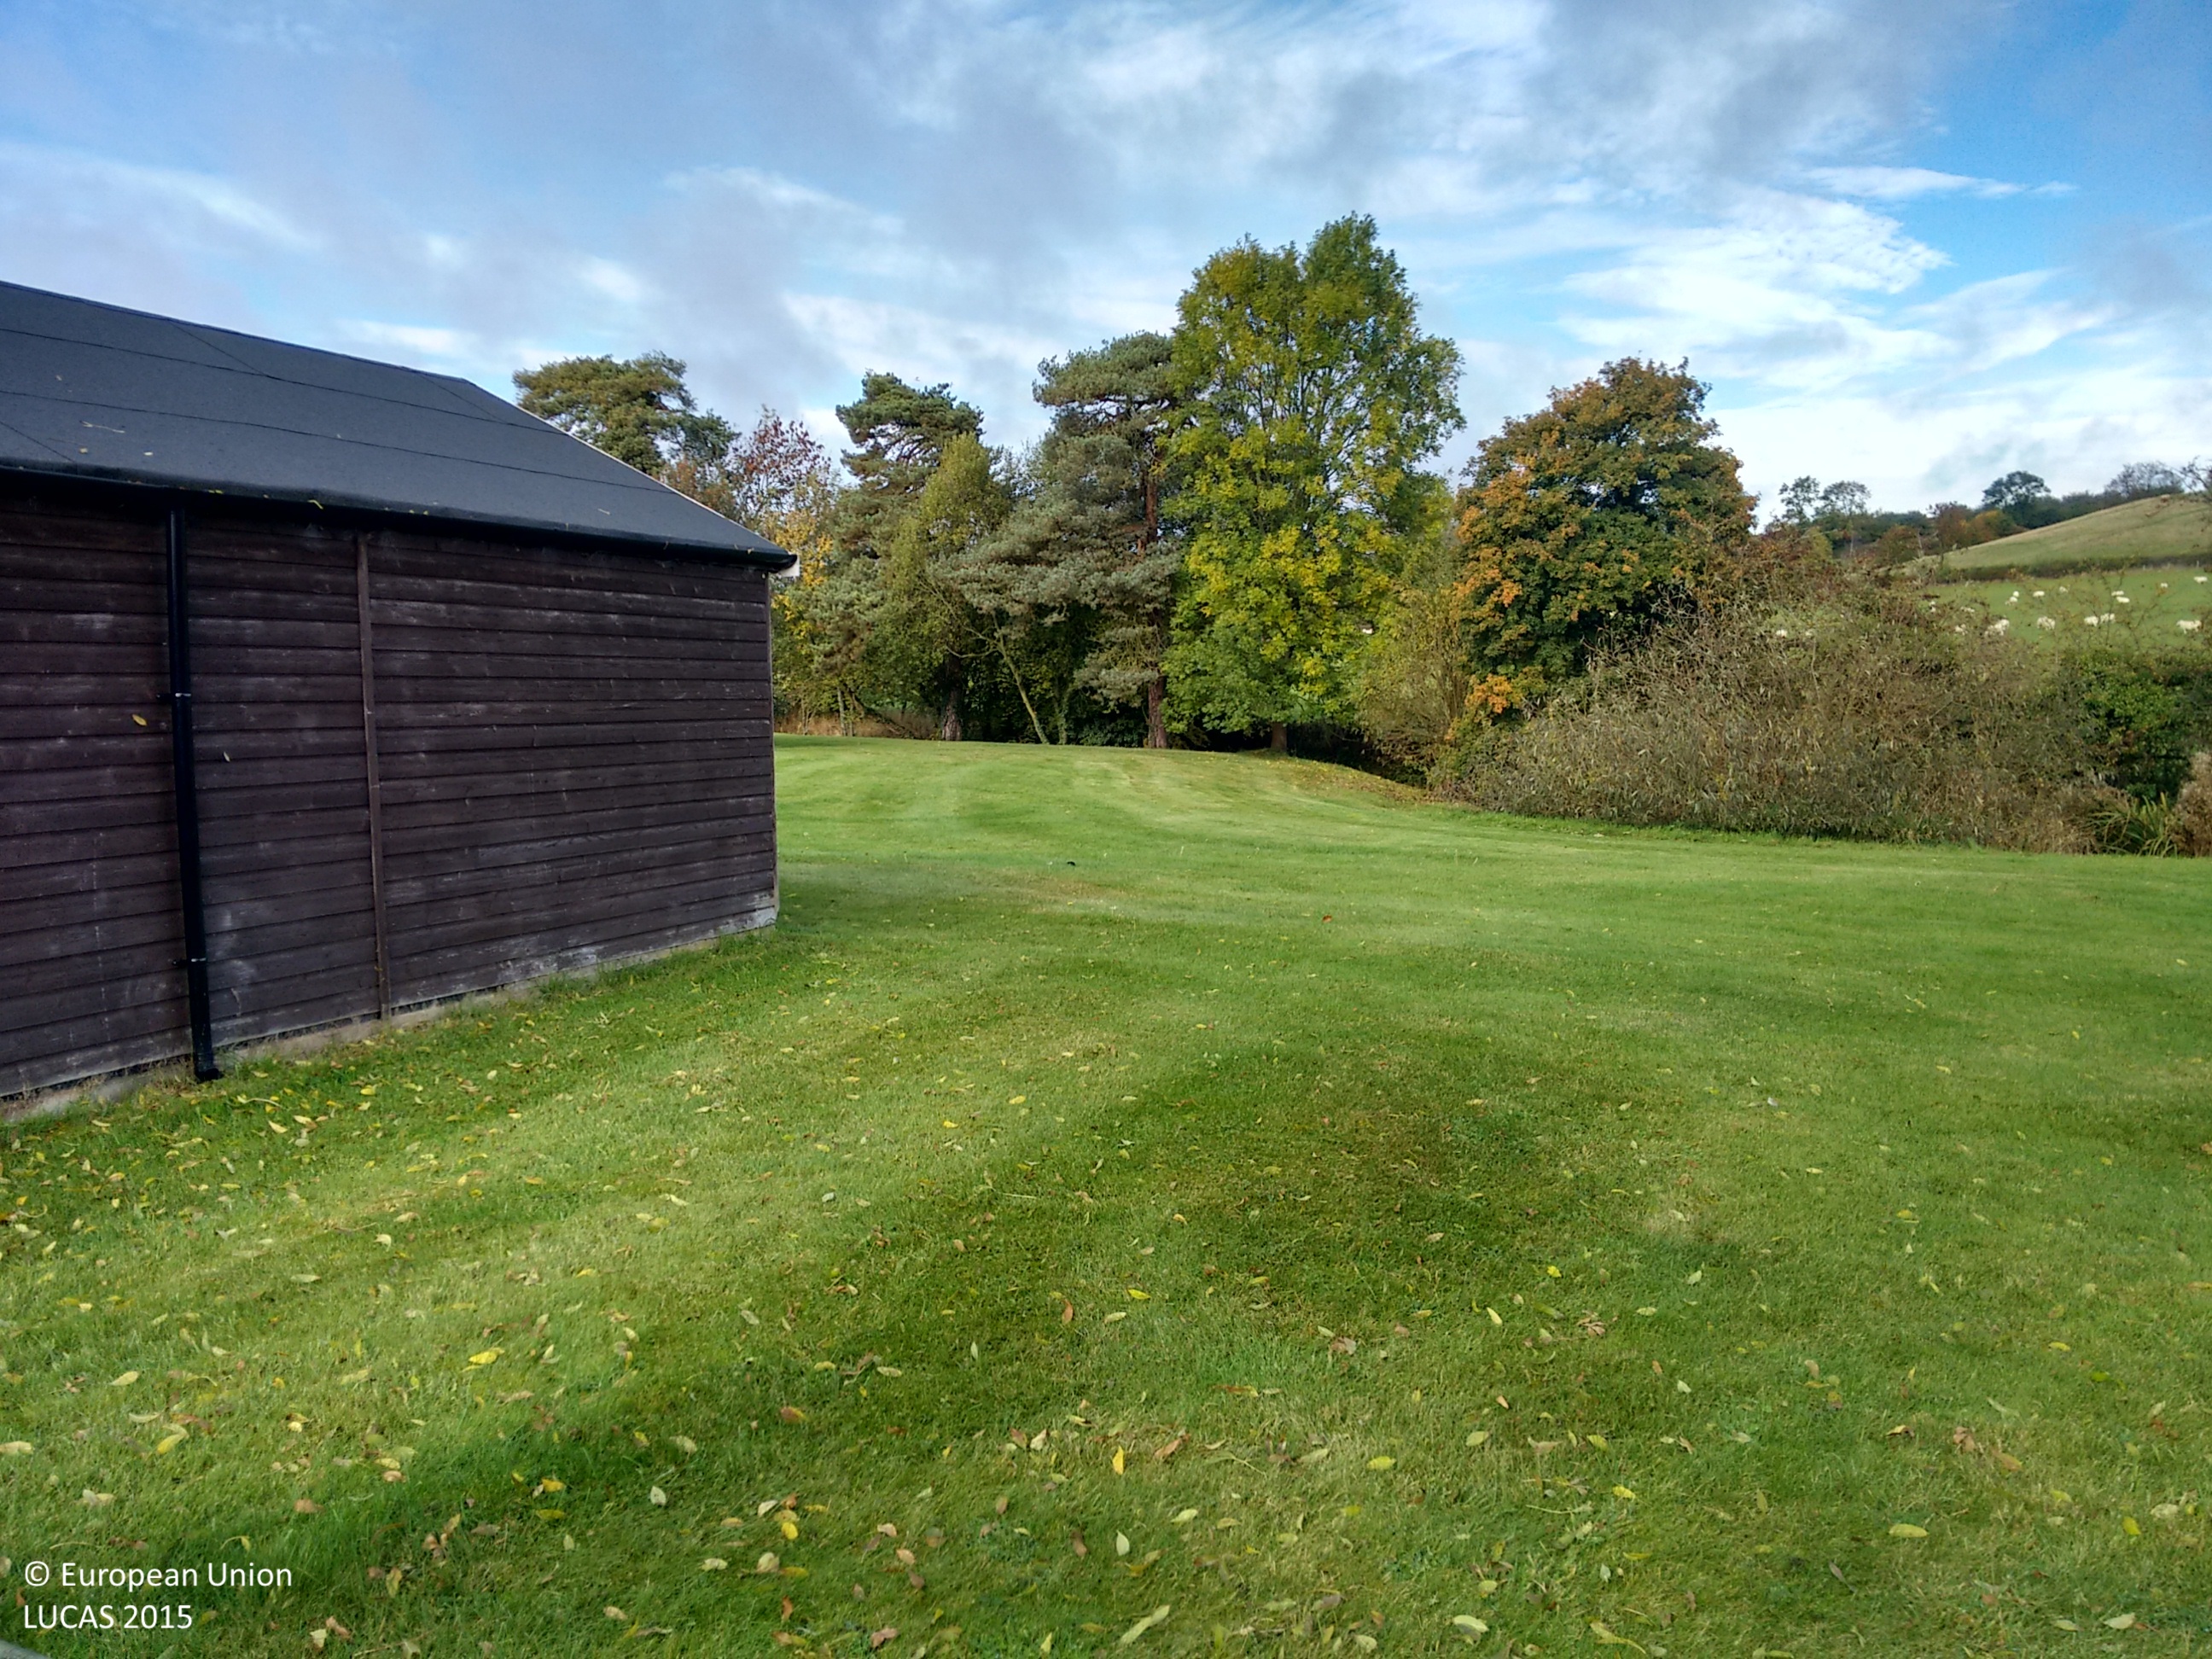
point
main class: Grassland
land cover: Grassland without tree/shrub cover
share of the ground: > 75 %
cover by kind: herbaceous plants 100 %
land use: Agriculture (excluding fallow land and kitchen gardens)
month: October
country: GB
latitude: 52.0505
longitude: -1.7053
